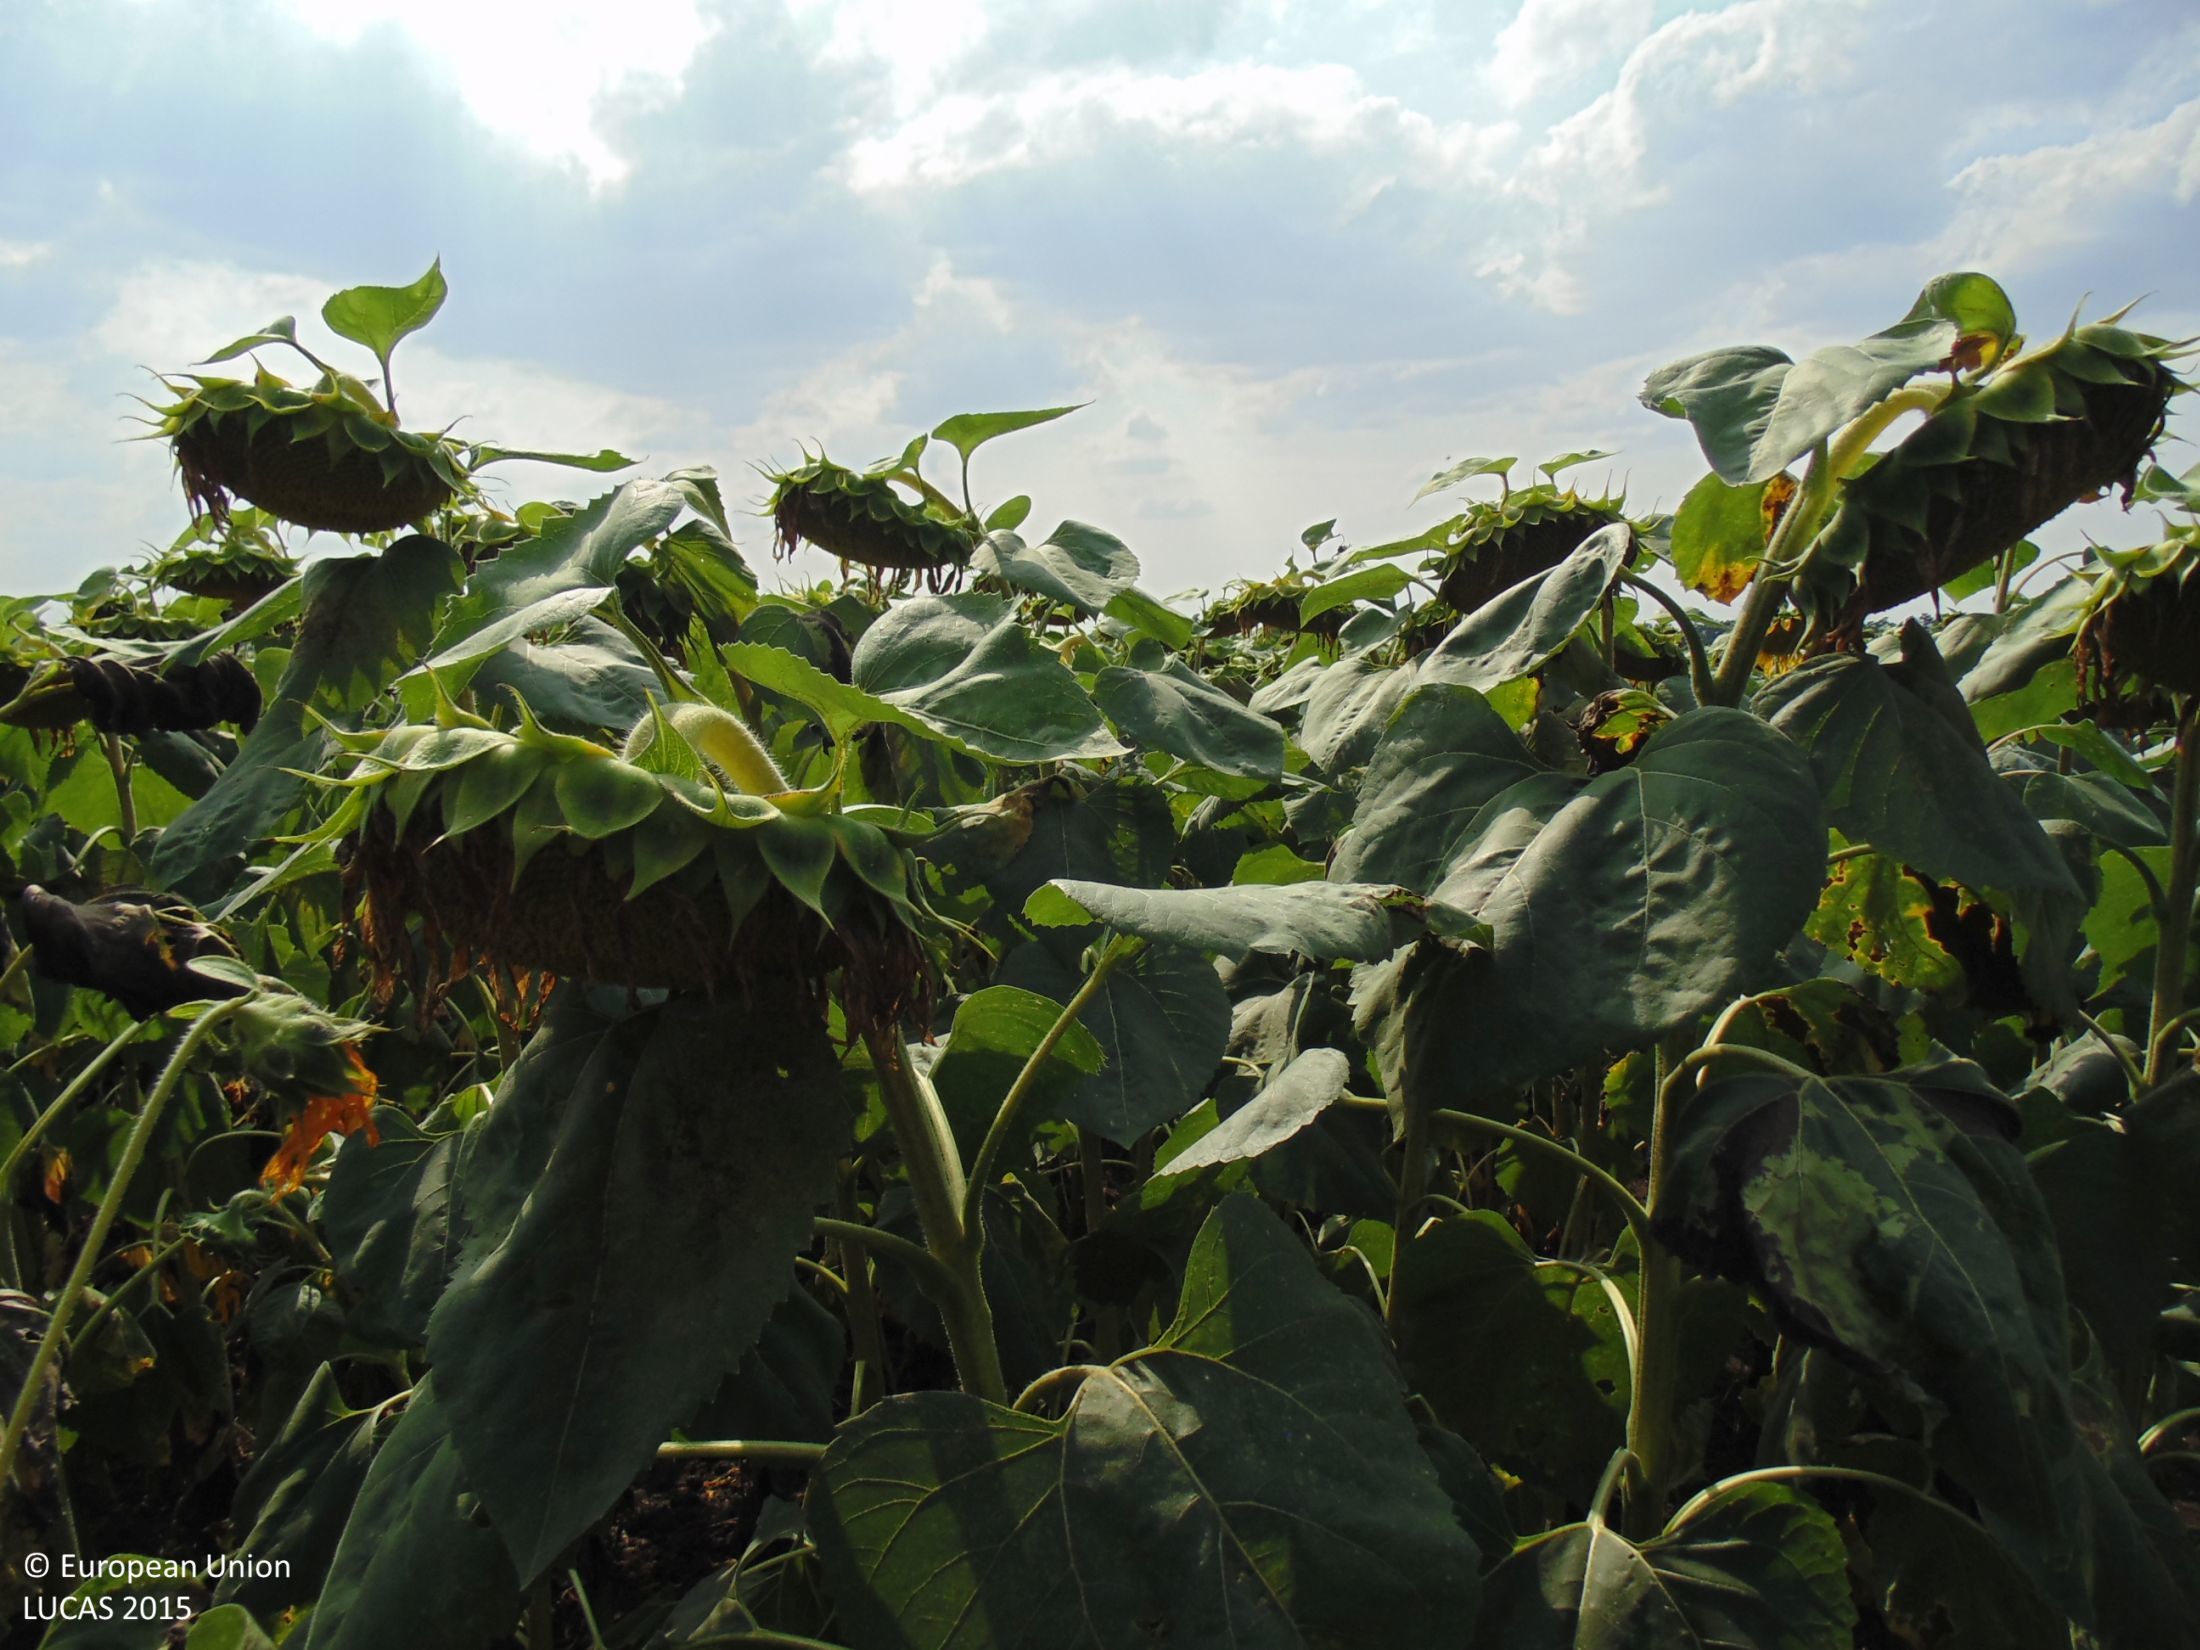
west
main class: Cropland
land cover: Sunflower
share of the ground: > 75 %
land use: Agriculture (excluding fallow land and kitchen gardens)
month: July
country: BG
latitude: 43.6046
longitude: 28.0248
